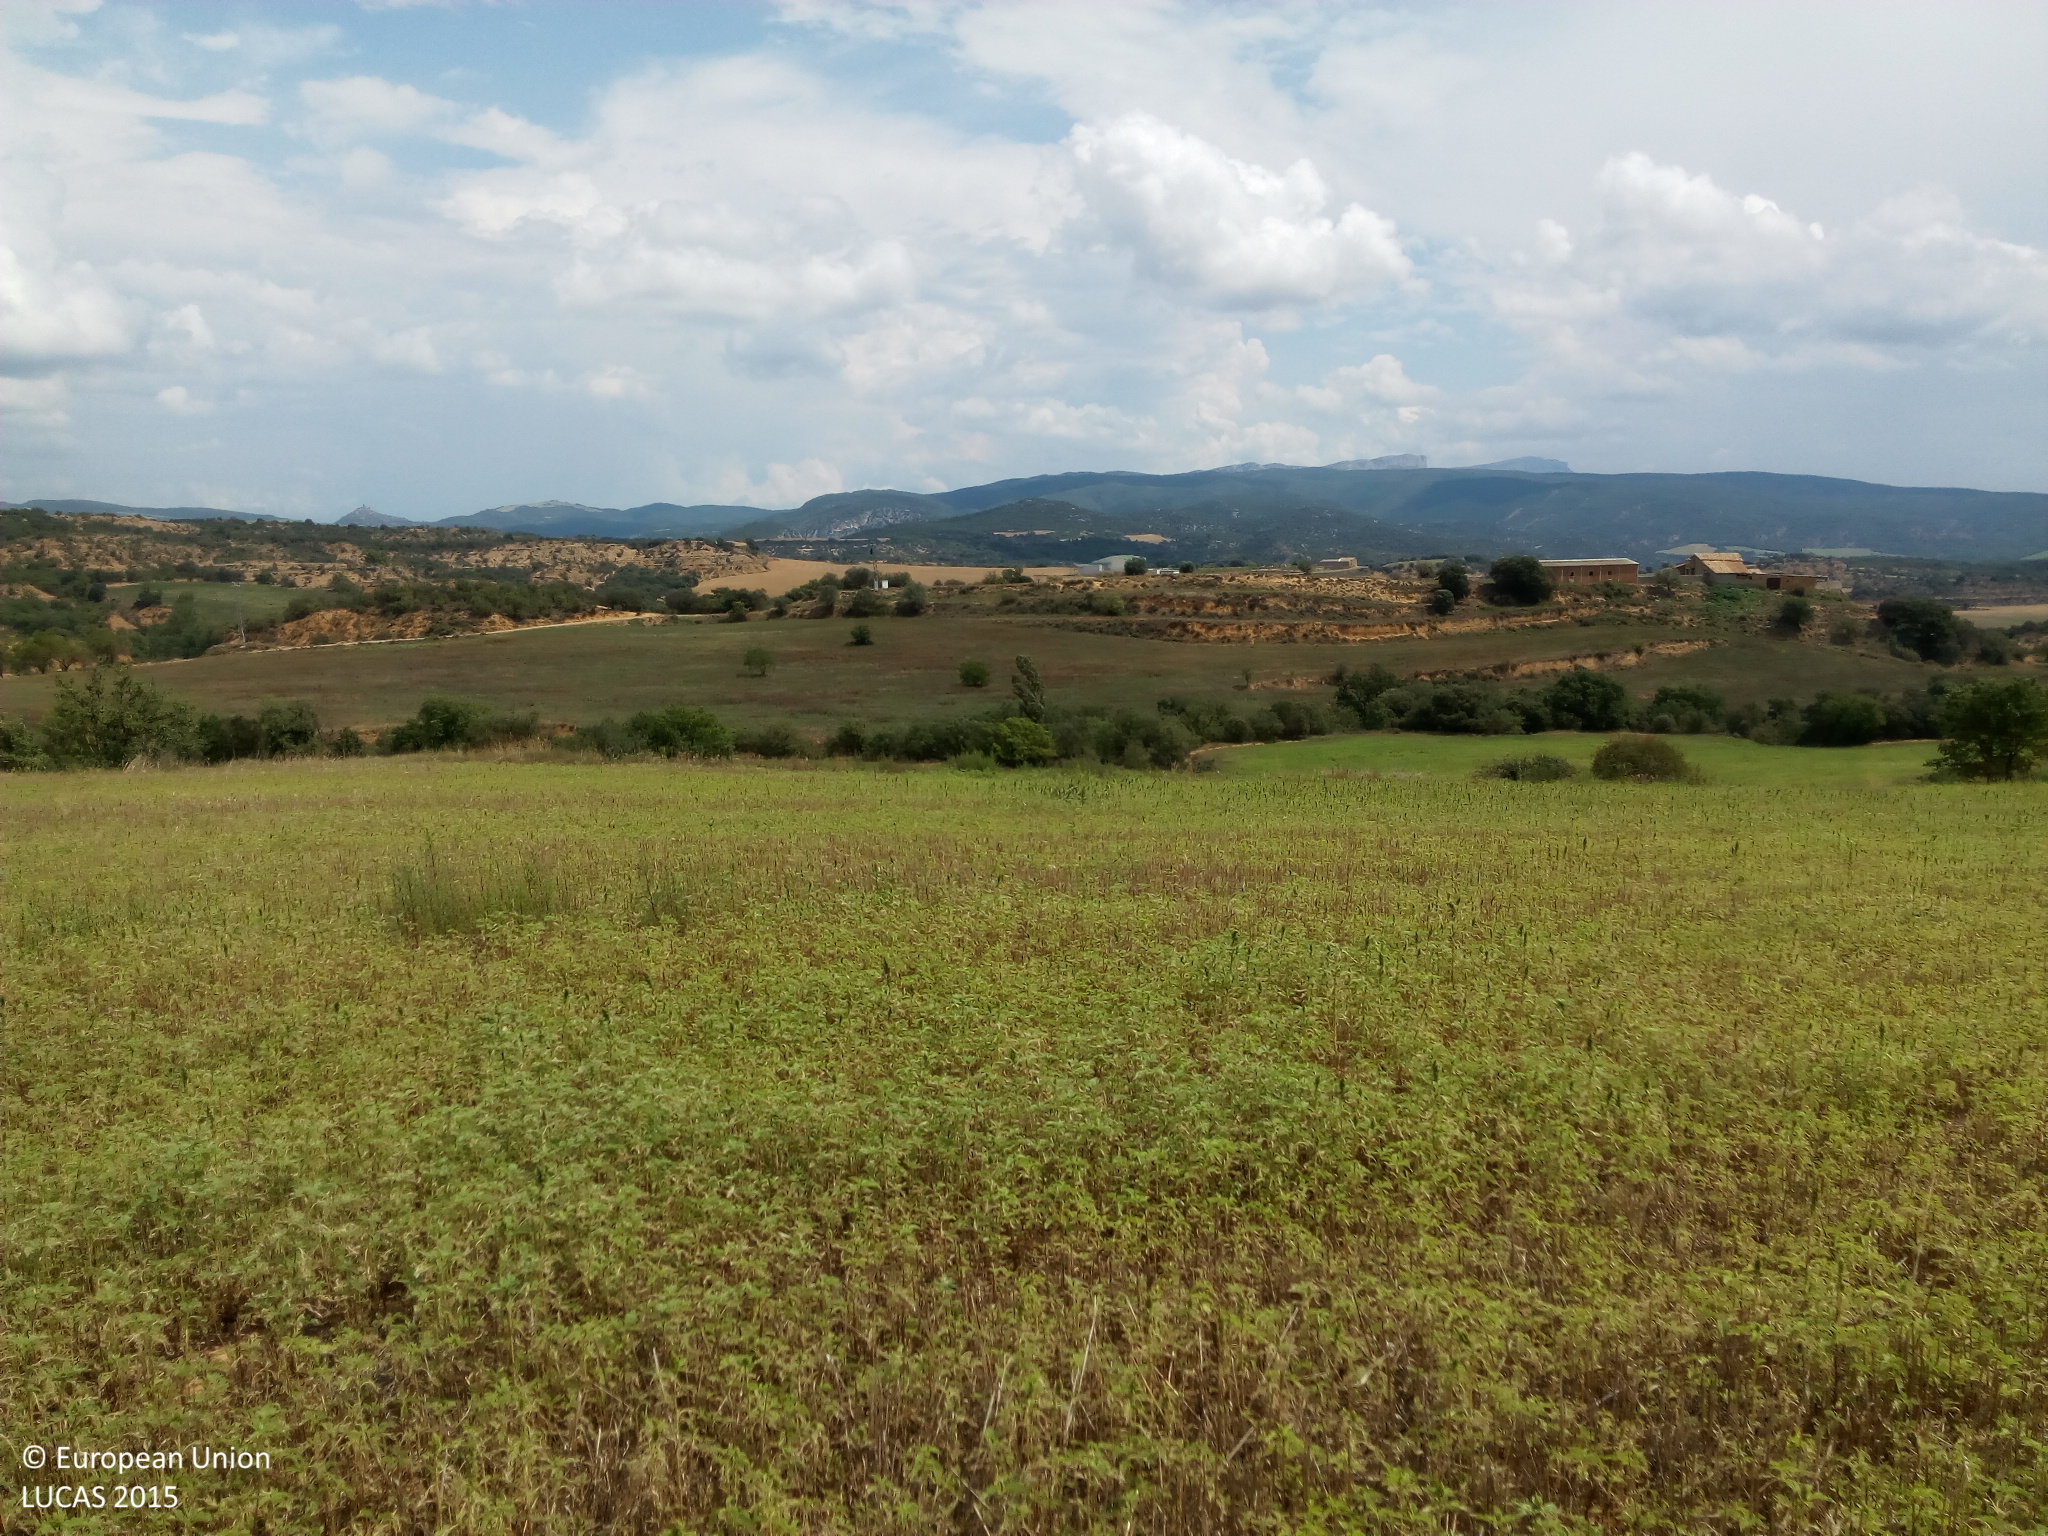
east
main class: Grassland
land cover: Spontaneously vegetated surfaces
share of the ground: > 75 %
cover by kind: herbaceous plants 100 %
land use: Fallow land
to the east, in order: Spontaneously vegetated surfaces; Grass margins; Spontaneously vegetated surfaces; Broadleaved woodland
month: August
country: ES
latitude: 42.0990
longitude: 0.5157
